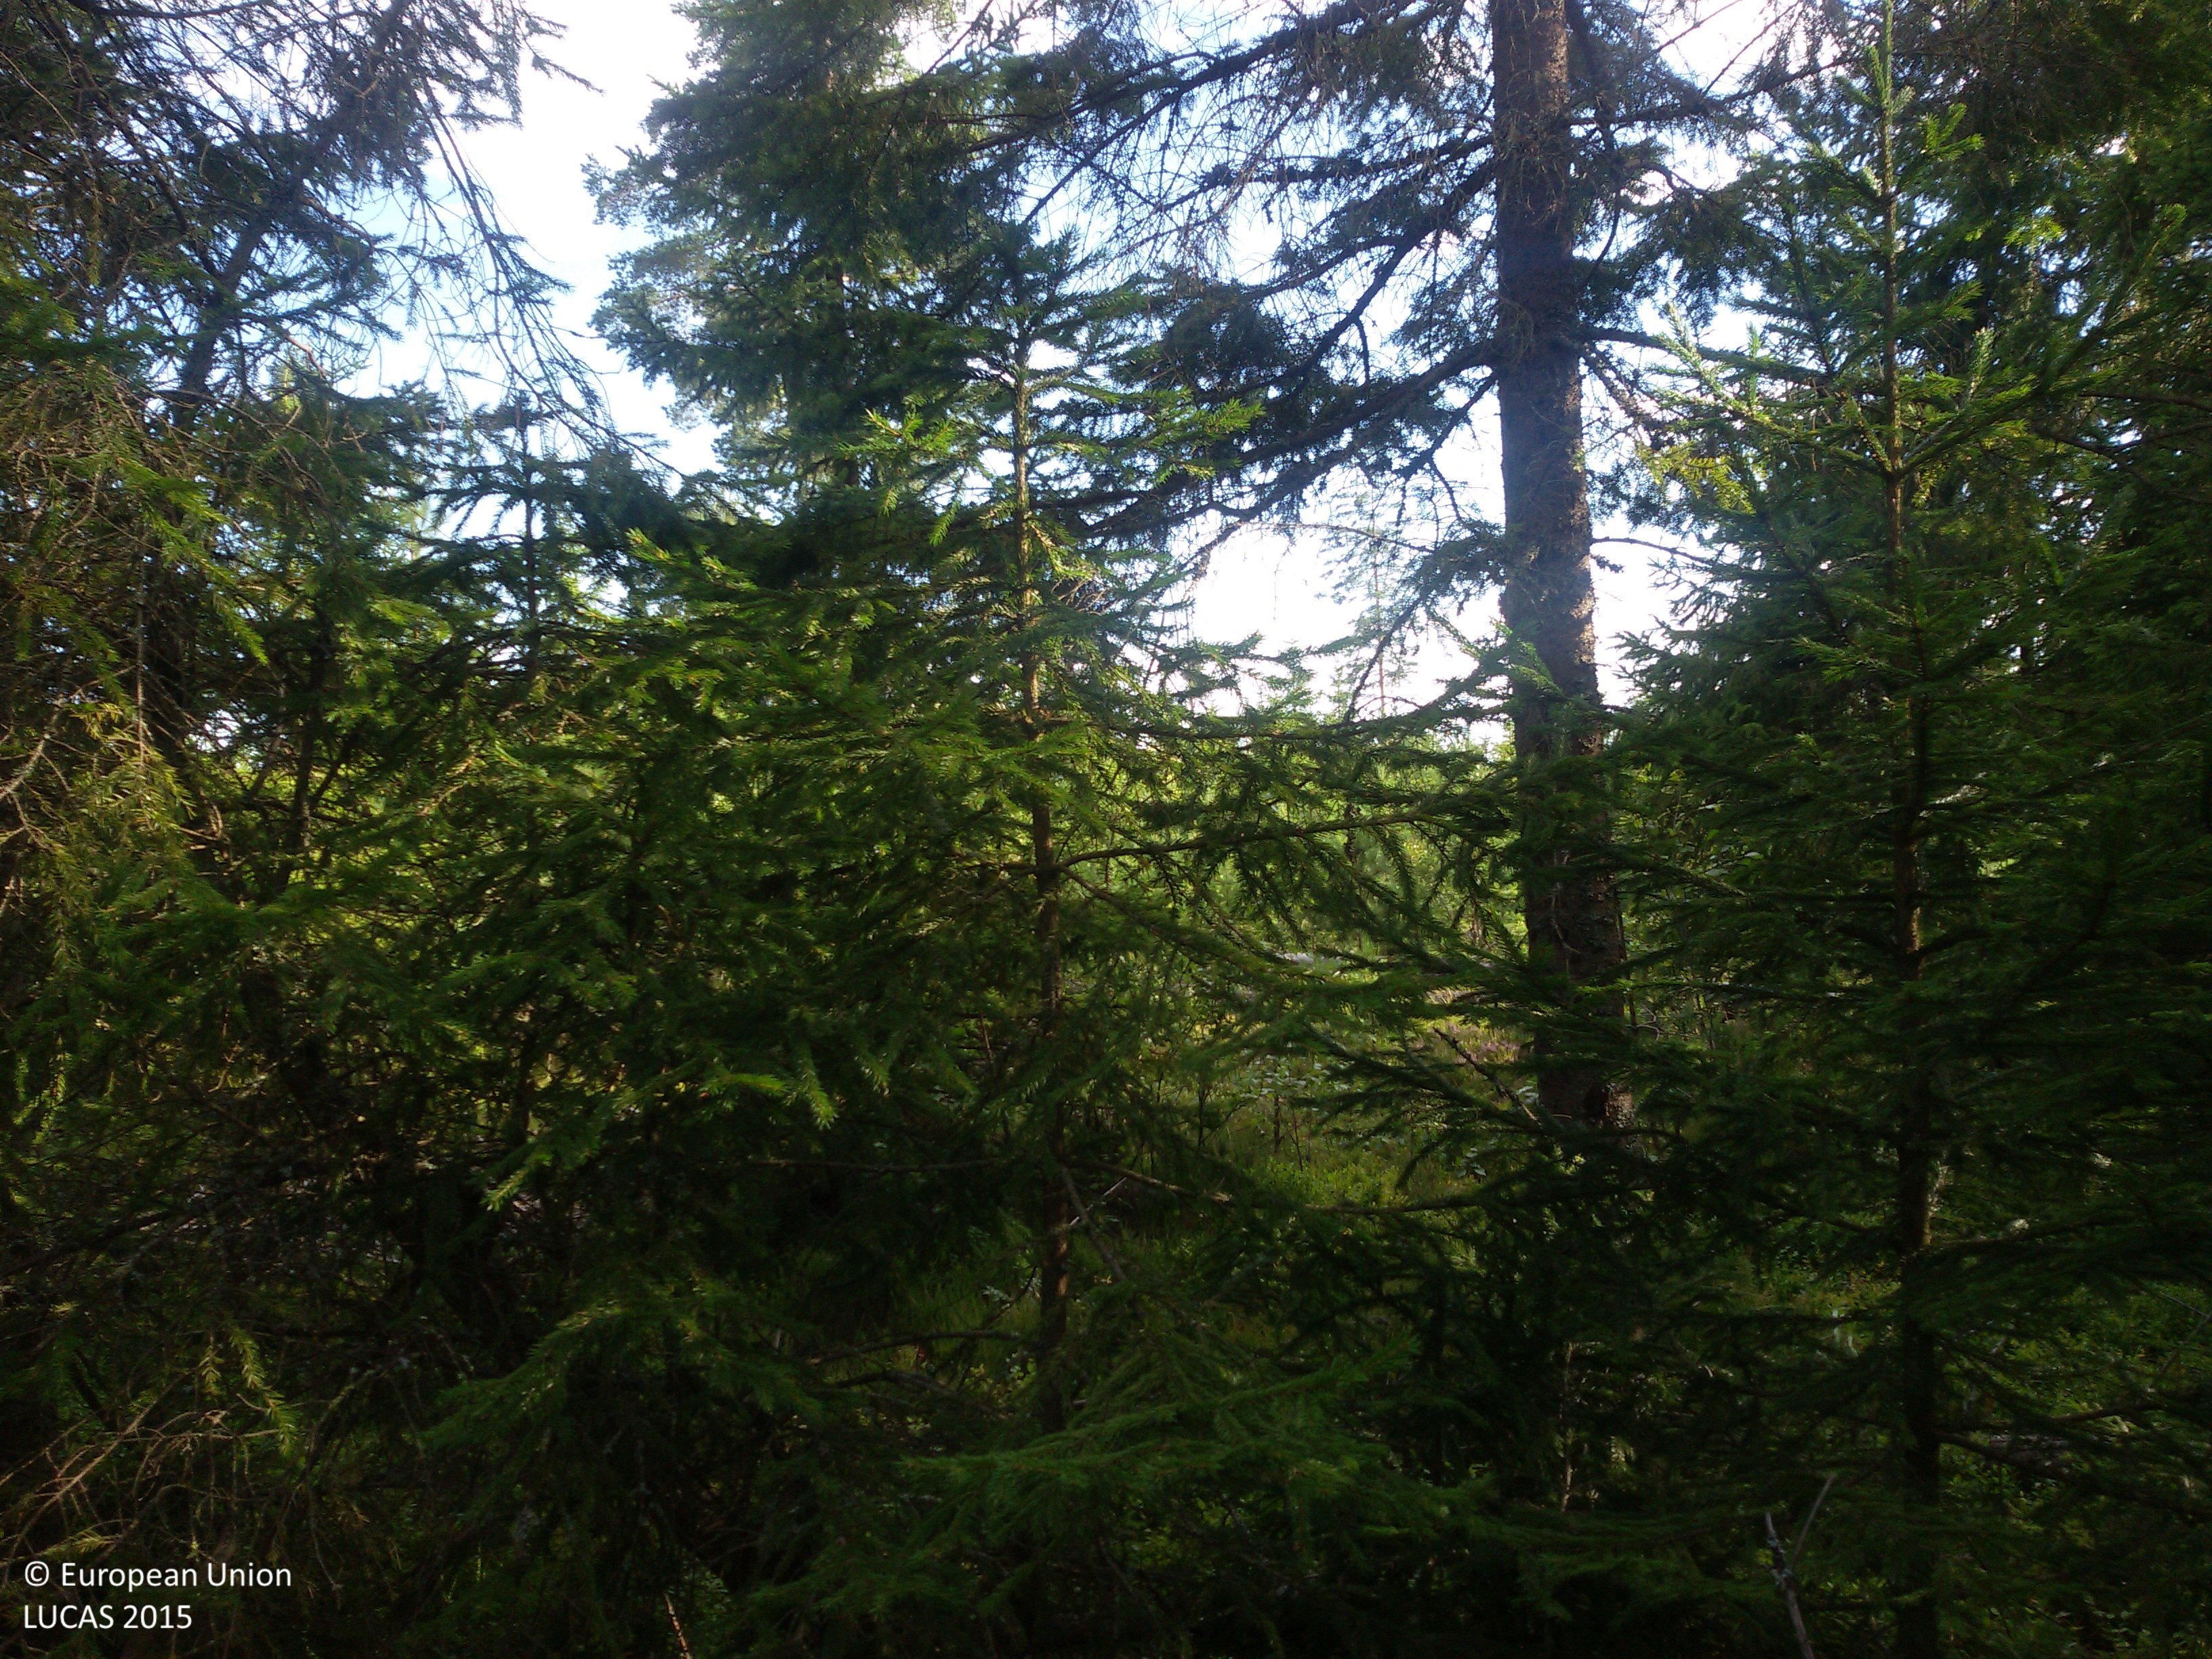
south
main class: Woodland
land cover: Spruce dominated coniferous woodland
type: boreal forest
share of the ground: 50 - 75 %
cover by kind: coniferous forest trees 70 %, lichens and mosses 15 %, shrubs 10 %, herbaceous plants 5 %
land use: Forestry
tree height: > 5 m
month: August
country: SE
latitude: 60.4067
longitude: 16.5787
